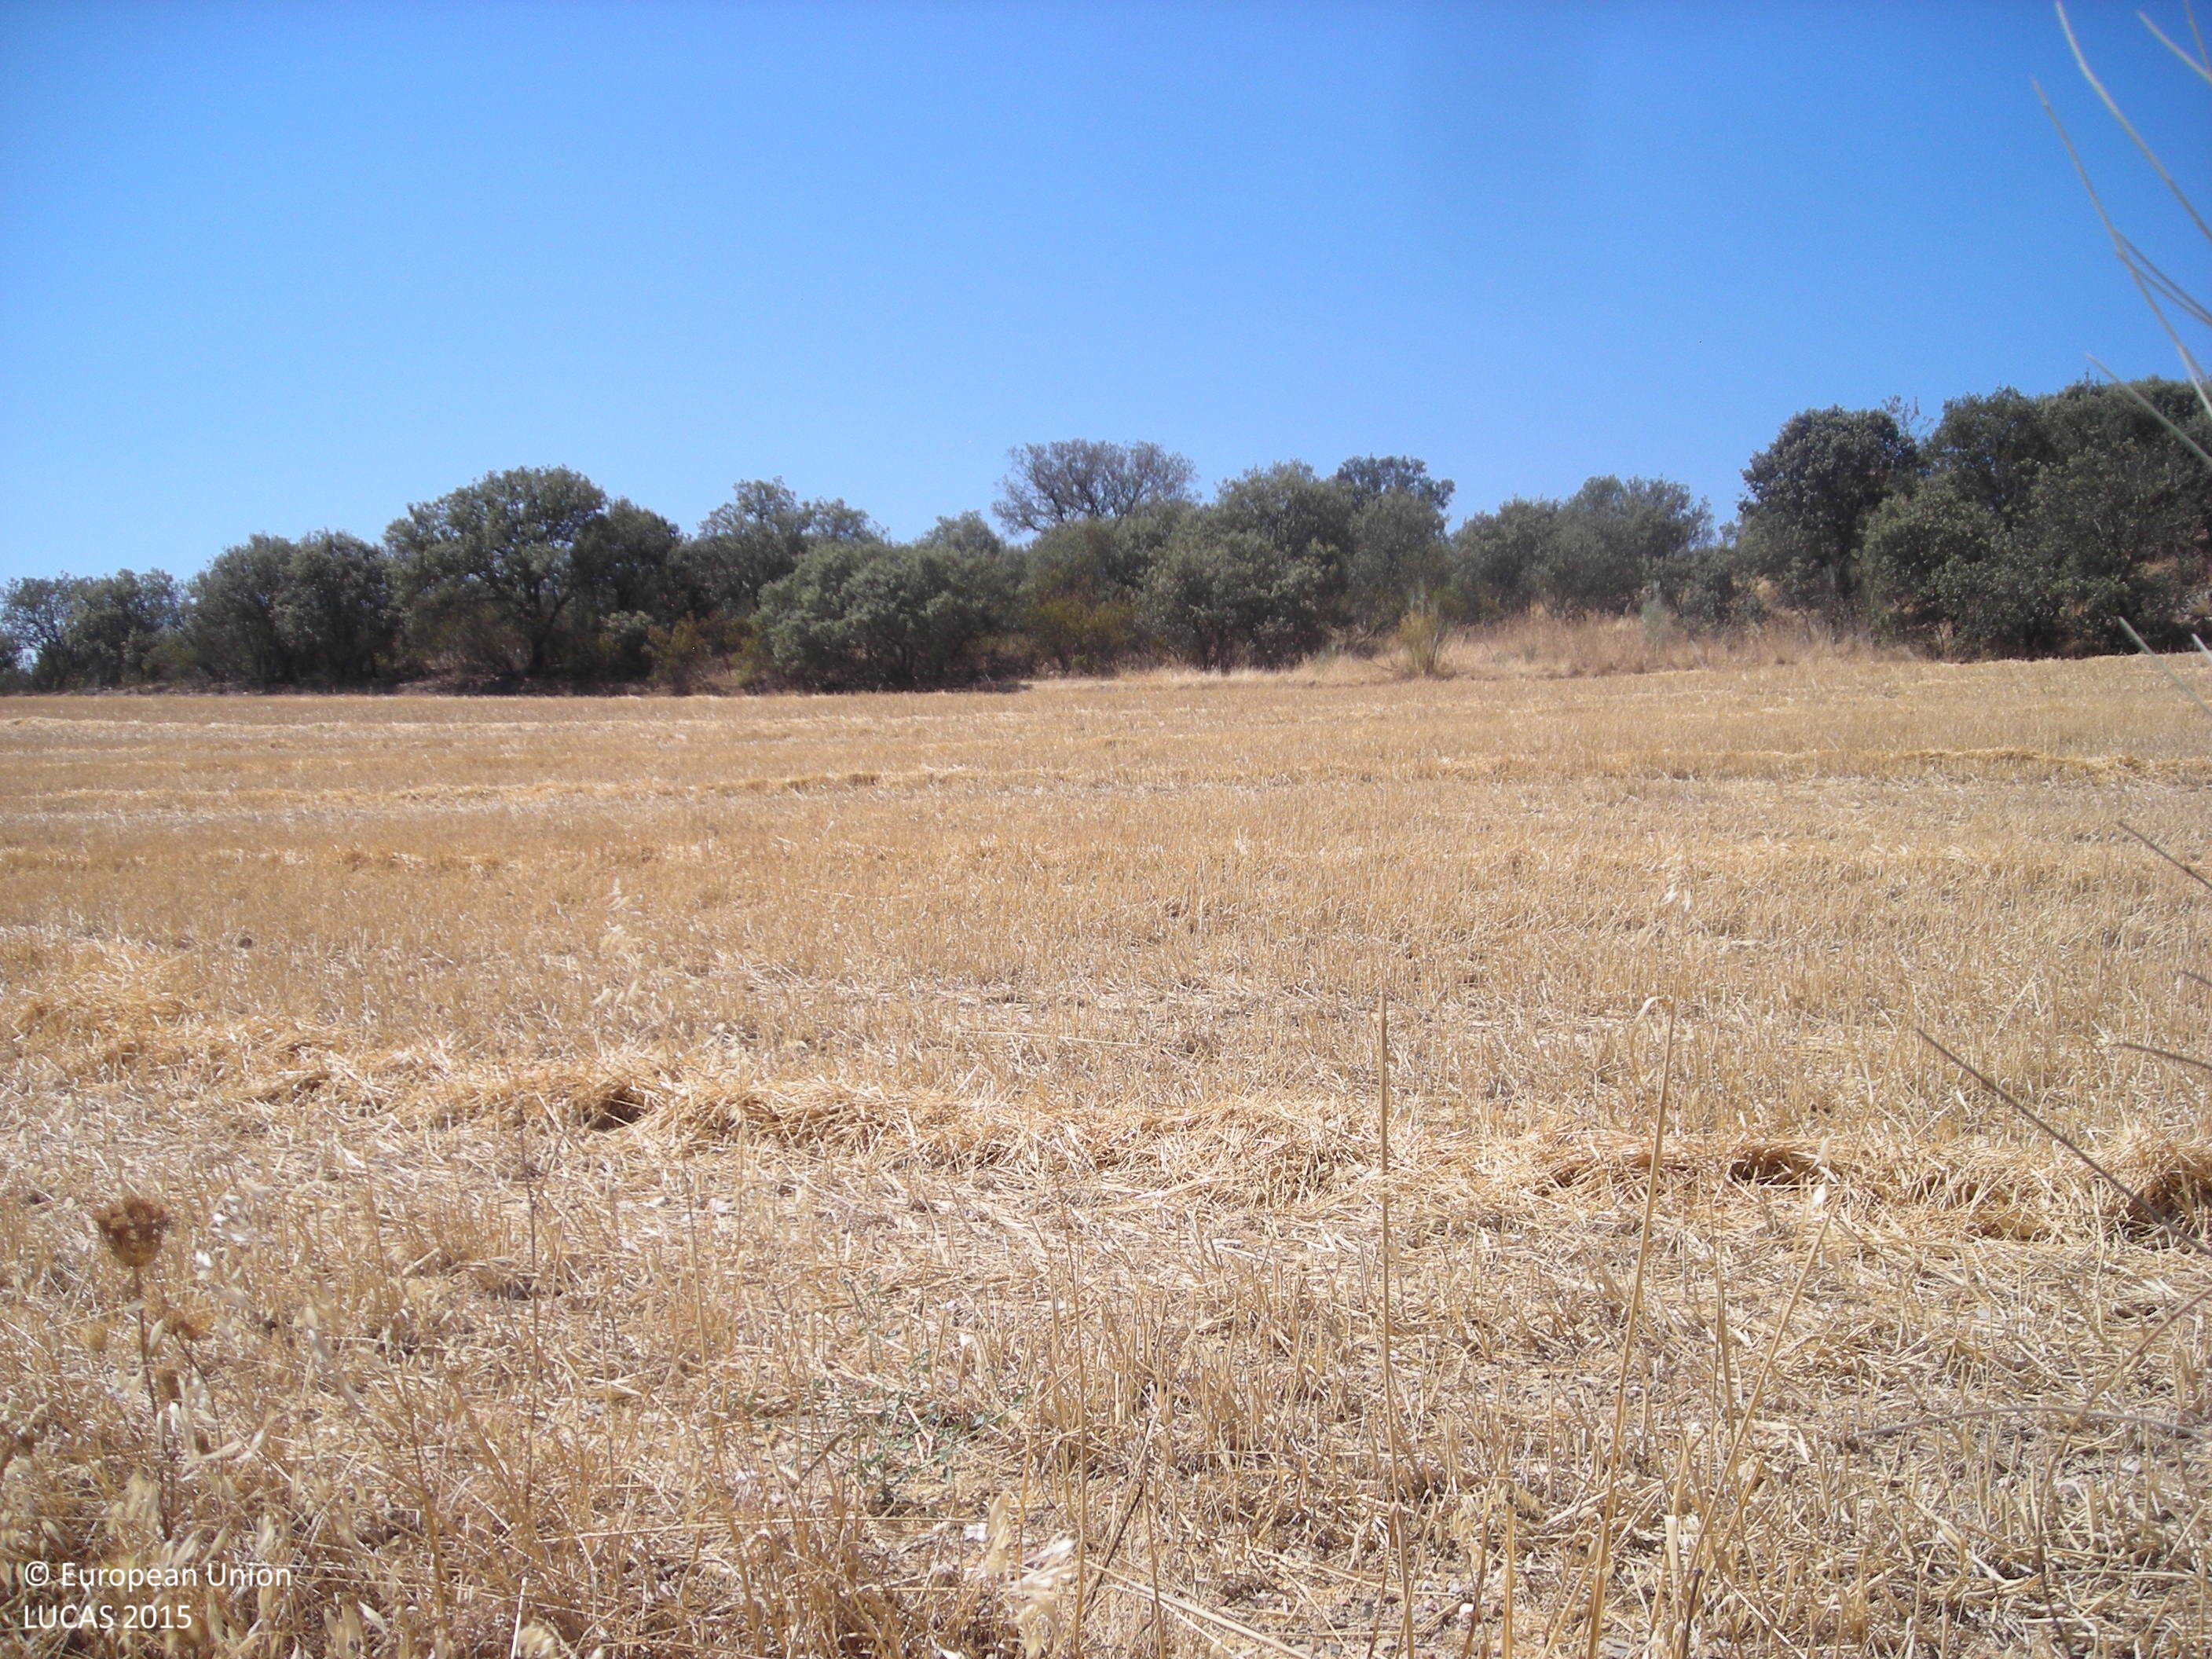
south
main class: Cropland
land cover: Temporary grasslands
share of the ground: > 75 %
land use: Agriculture (excluding fallow land and kitchen gardens)
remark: Harvested field
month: July
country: ES
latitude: 38.8094
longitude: -5.9284
